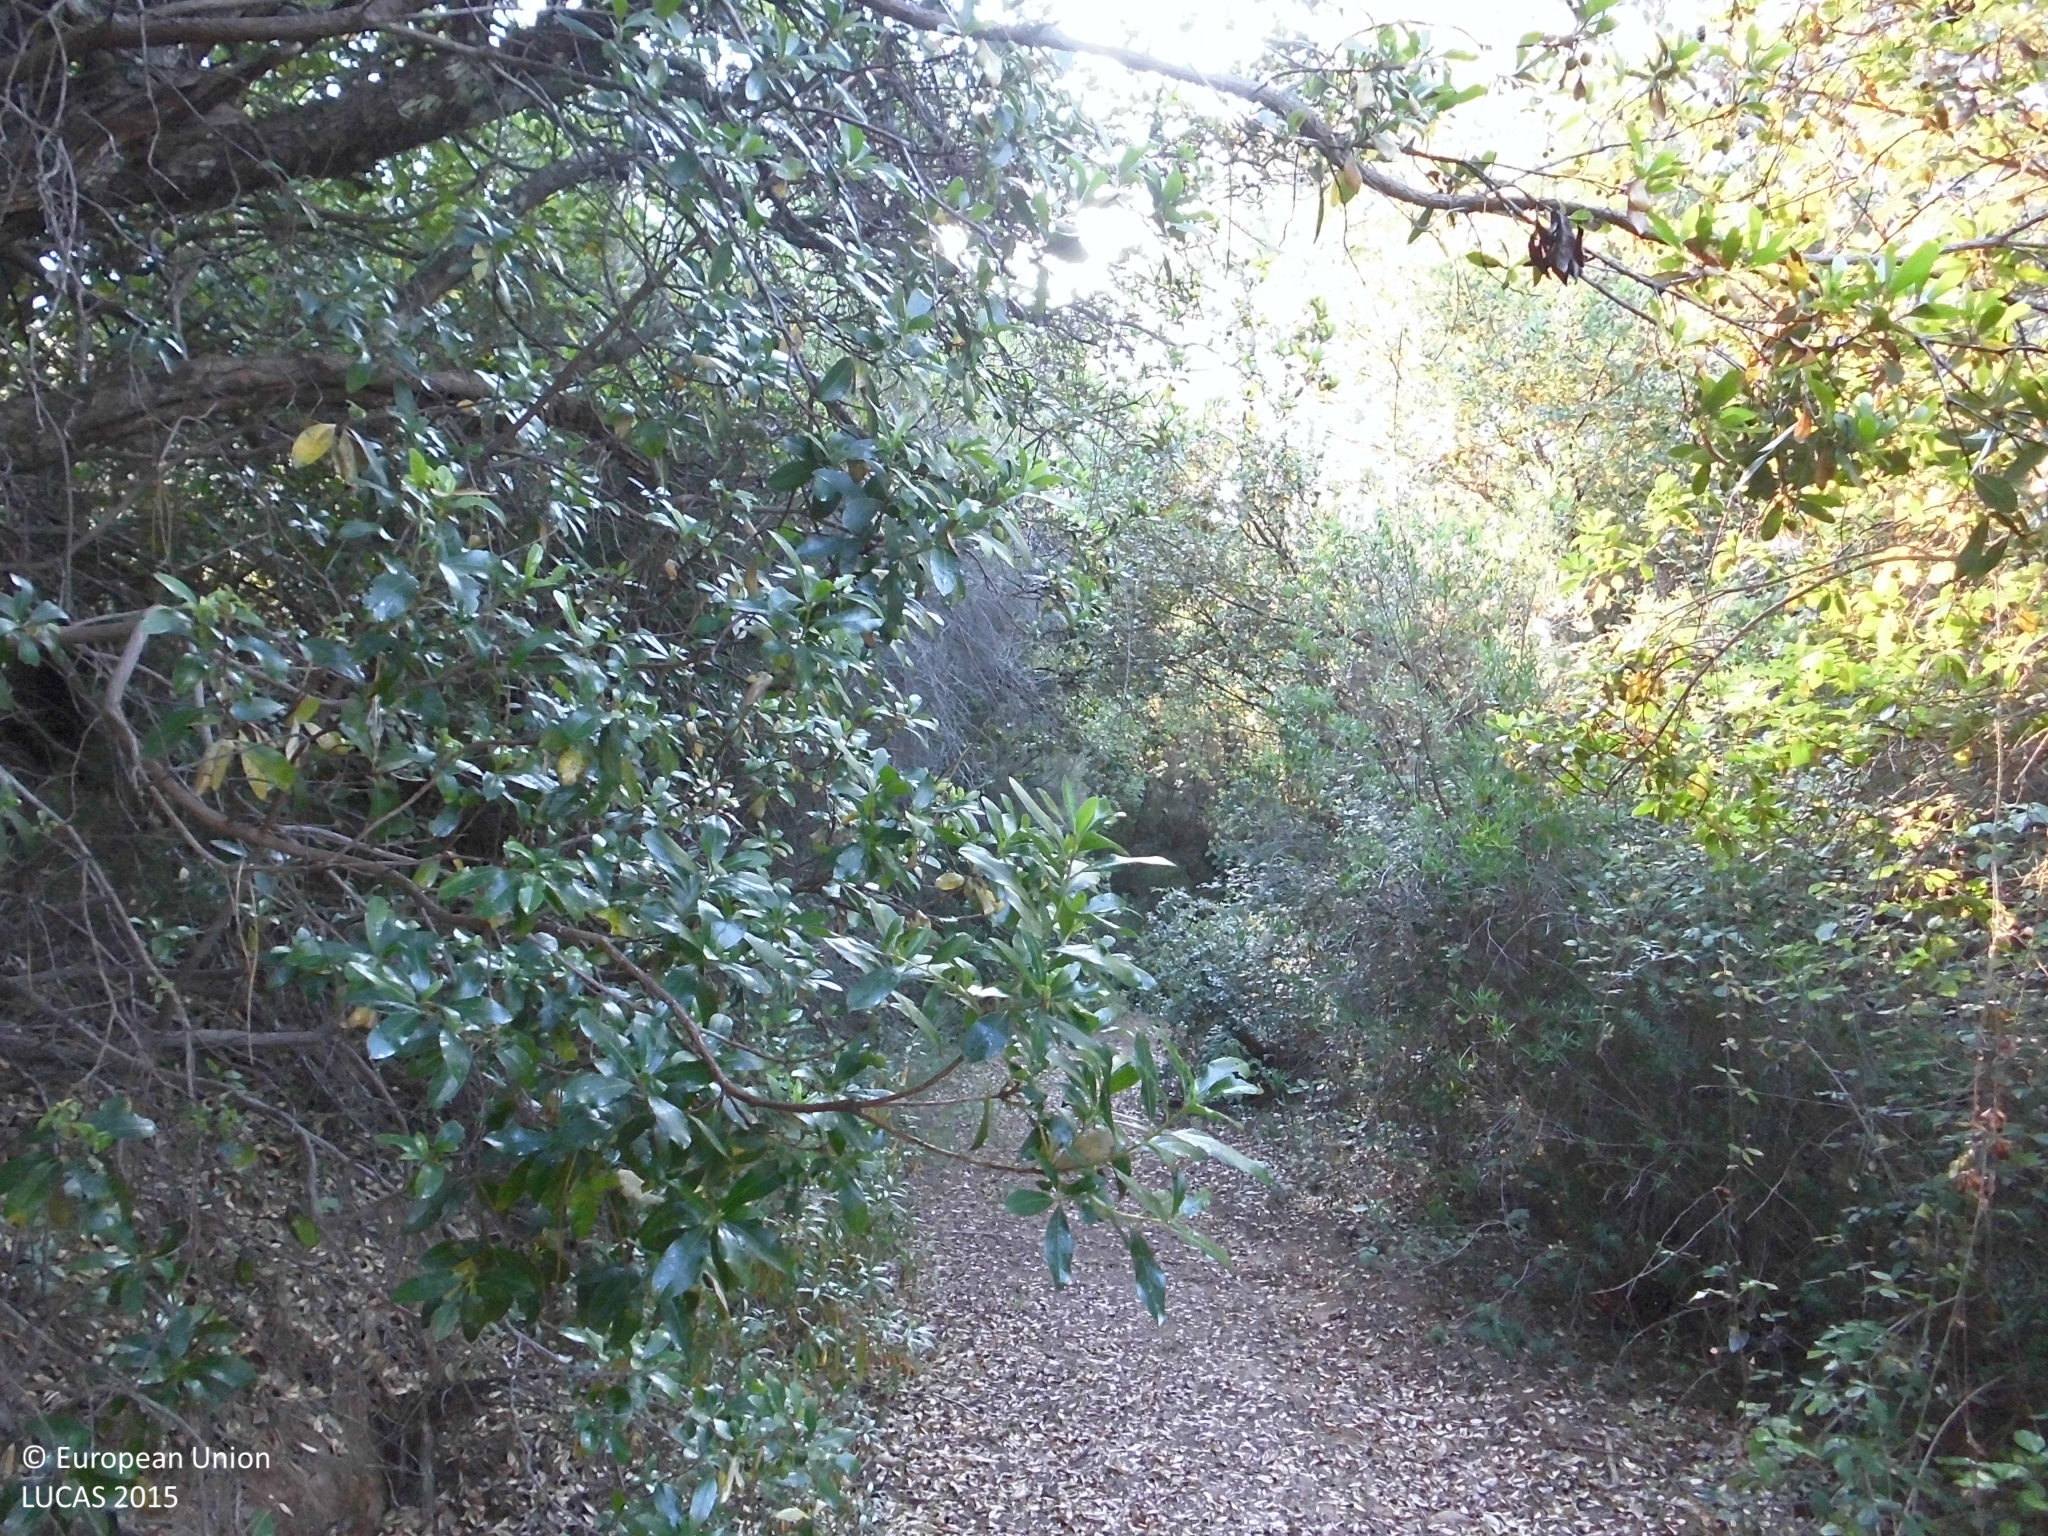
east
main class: Woodland
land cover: Pine dominated mixed woodland
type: thermophilous deciduous forest
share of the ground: > 75 %
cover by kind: coniferous forest trees 50 %, broadleaved forest trees 25 %, shrubs 20 %, herbaceous plants 5 %
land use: Forestry
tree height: > 5 m
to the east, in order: Pine dominated mixed woodland; Shrubland without tree cover; Pine dominated mixed woodland
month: June
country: ES
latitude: 40.1169
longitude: -5.4668
